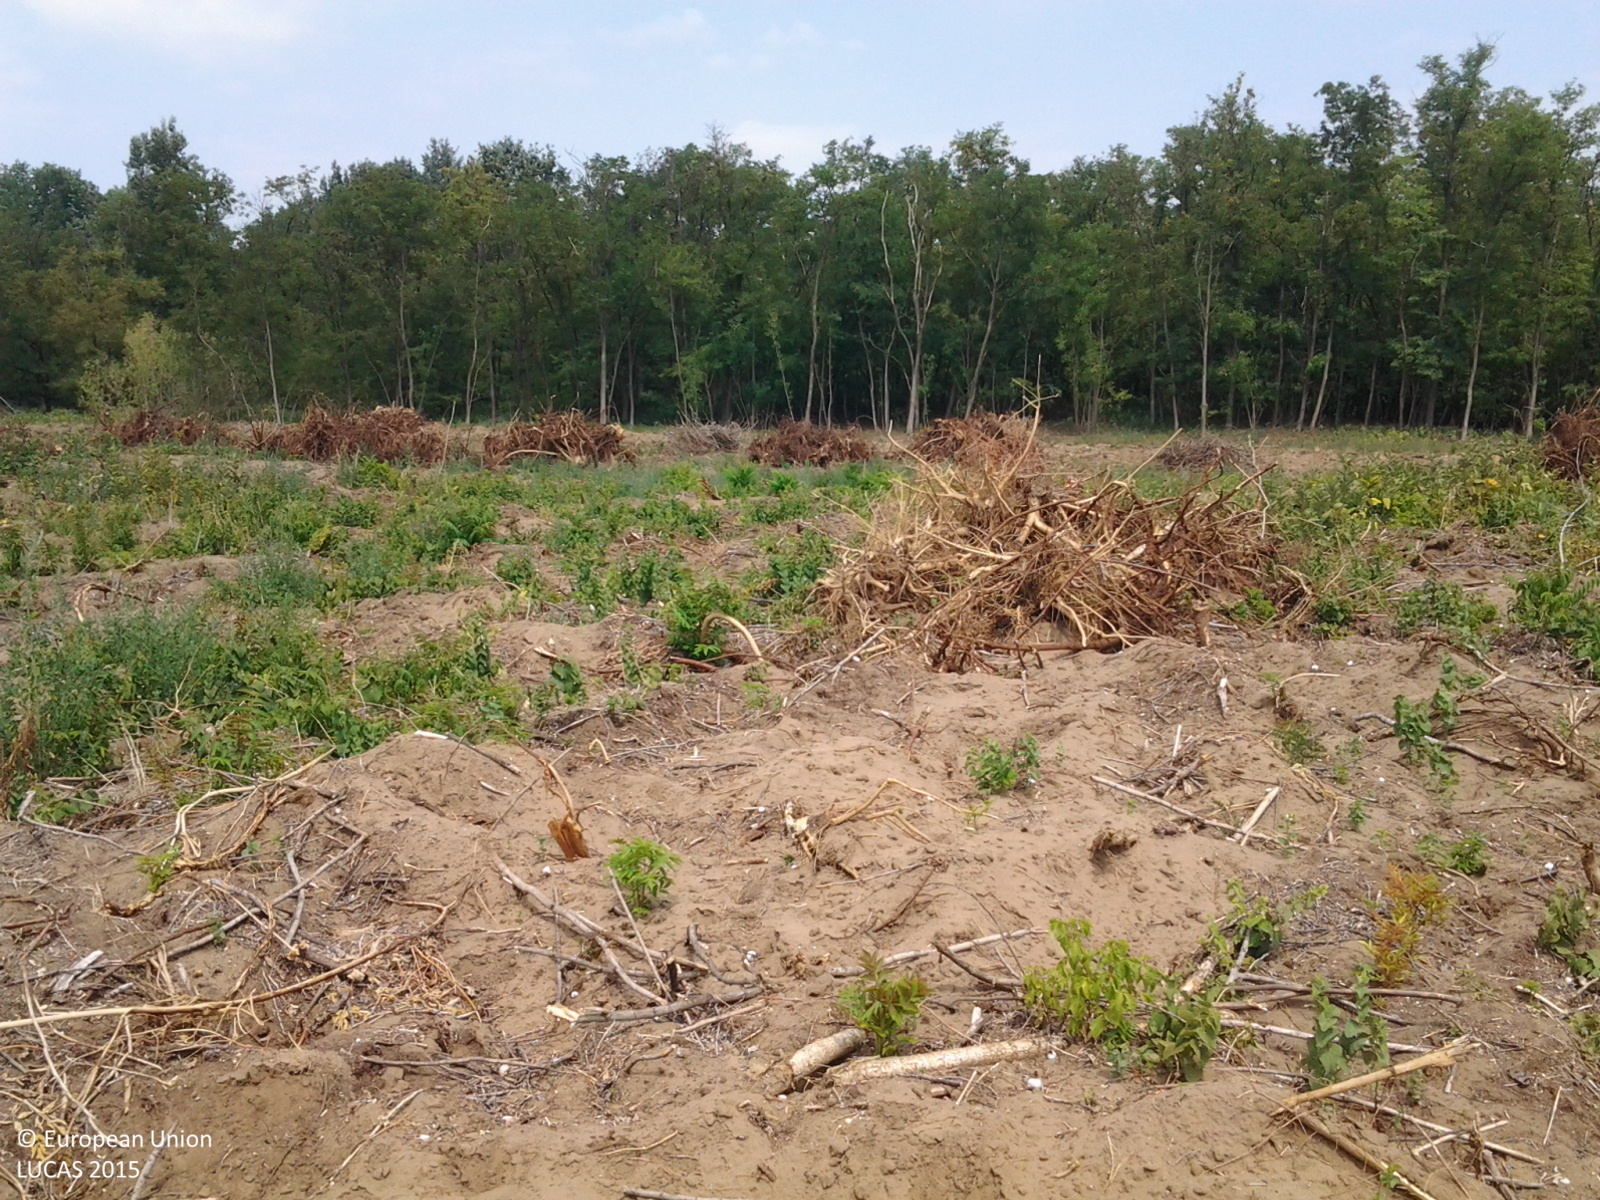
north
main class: Grassland
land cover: Spontaneously vegetated surfaces
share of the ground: 50 - 75 %
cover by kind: herbaceous plants 60 %, unconsolidated bare surface 40 %
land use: Forestry
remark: Clear cut
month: July
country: HU
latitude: 47.4120
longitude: 19.9250
